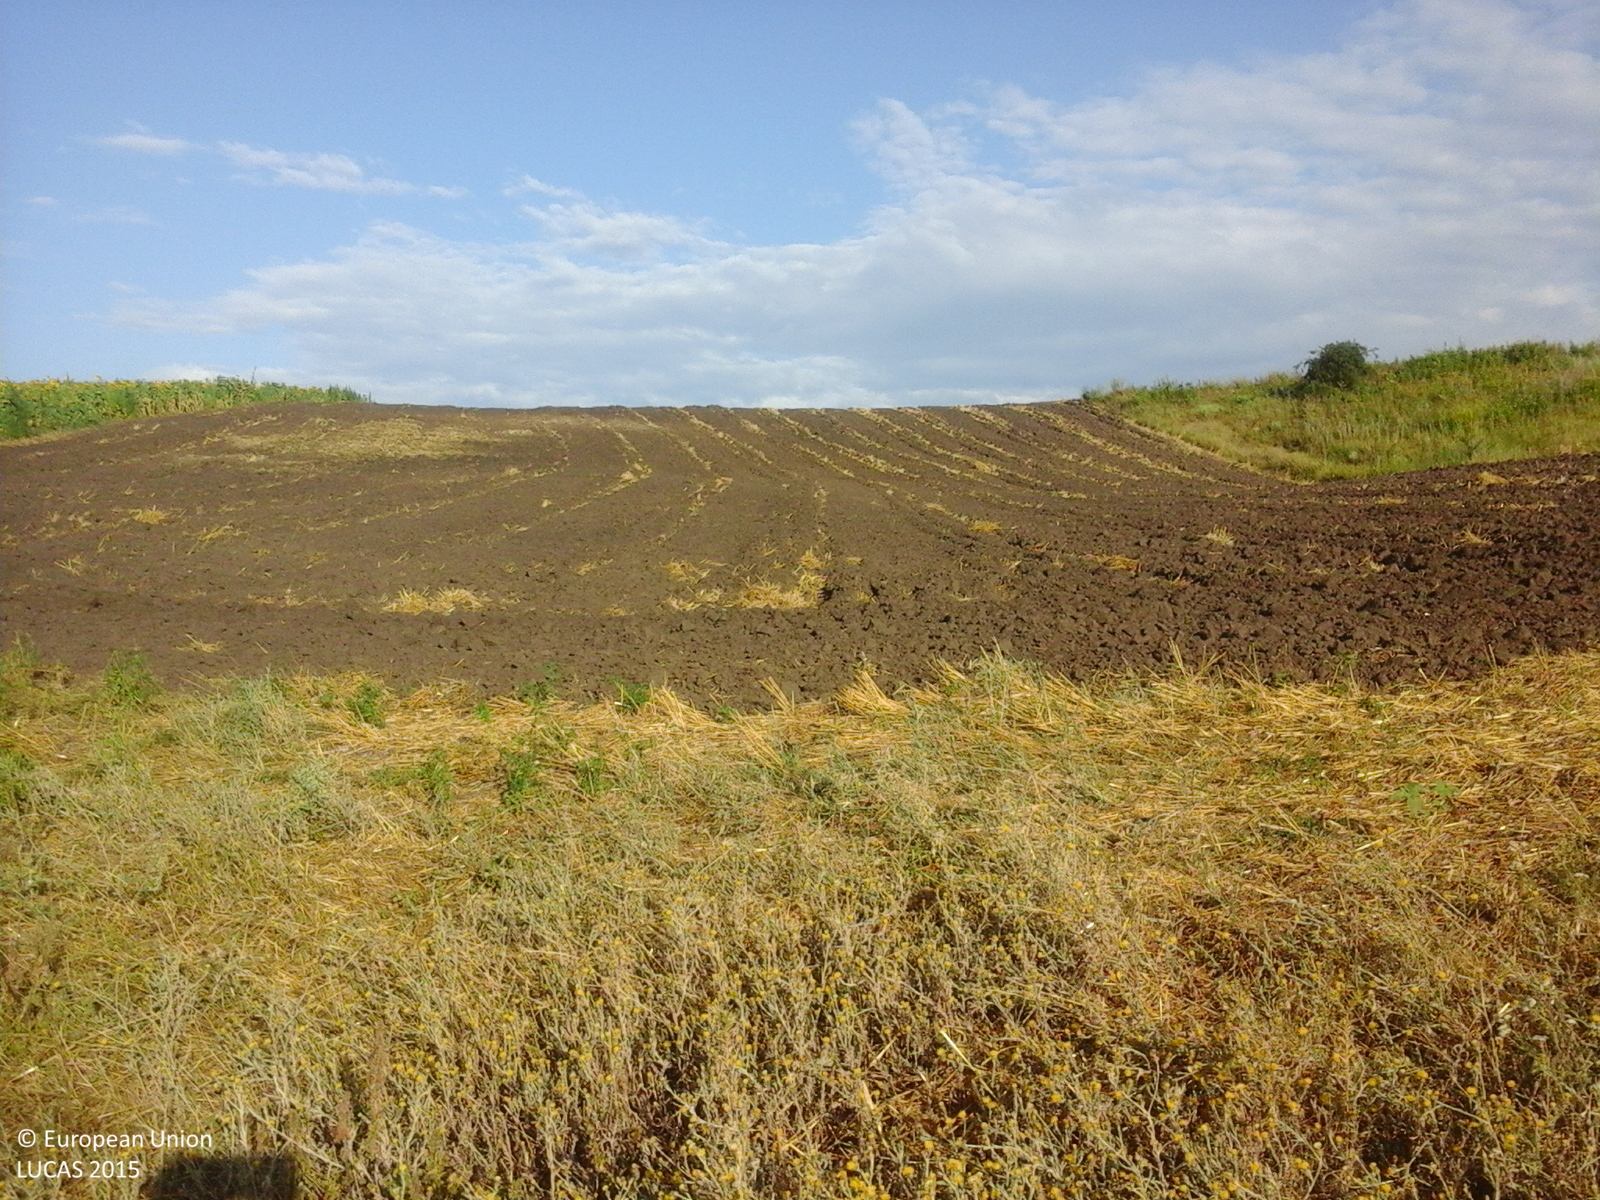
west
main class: Grassland
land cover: Grassland without tree/shrub cover
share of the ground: > 75 %
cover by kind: herbaceous plants 100 %
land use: Agriculture (excluding fallow land and kitchen gardens)
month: July
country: RO
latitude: 46.2176
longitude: 27.7328
